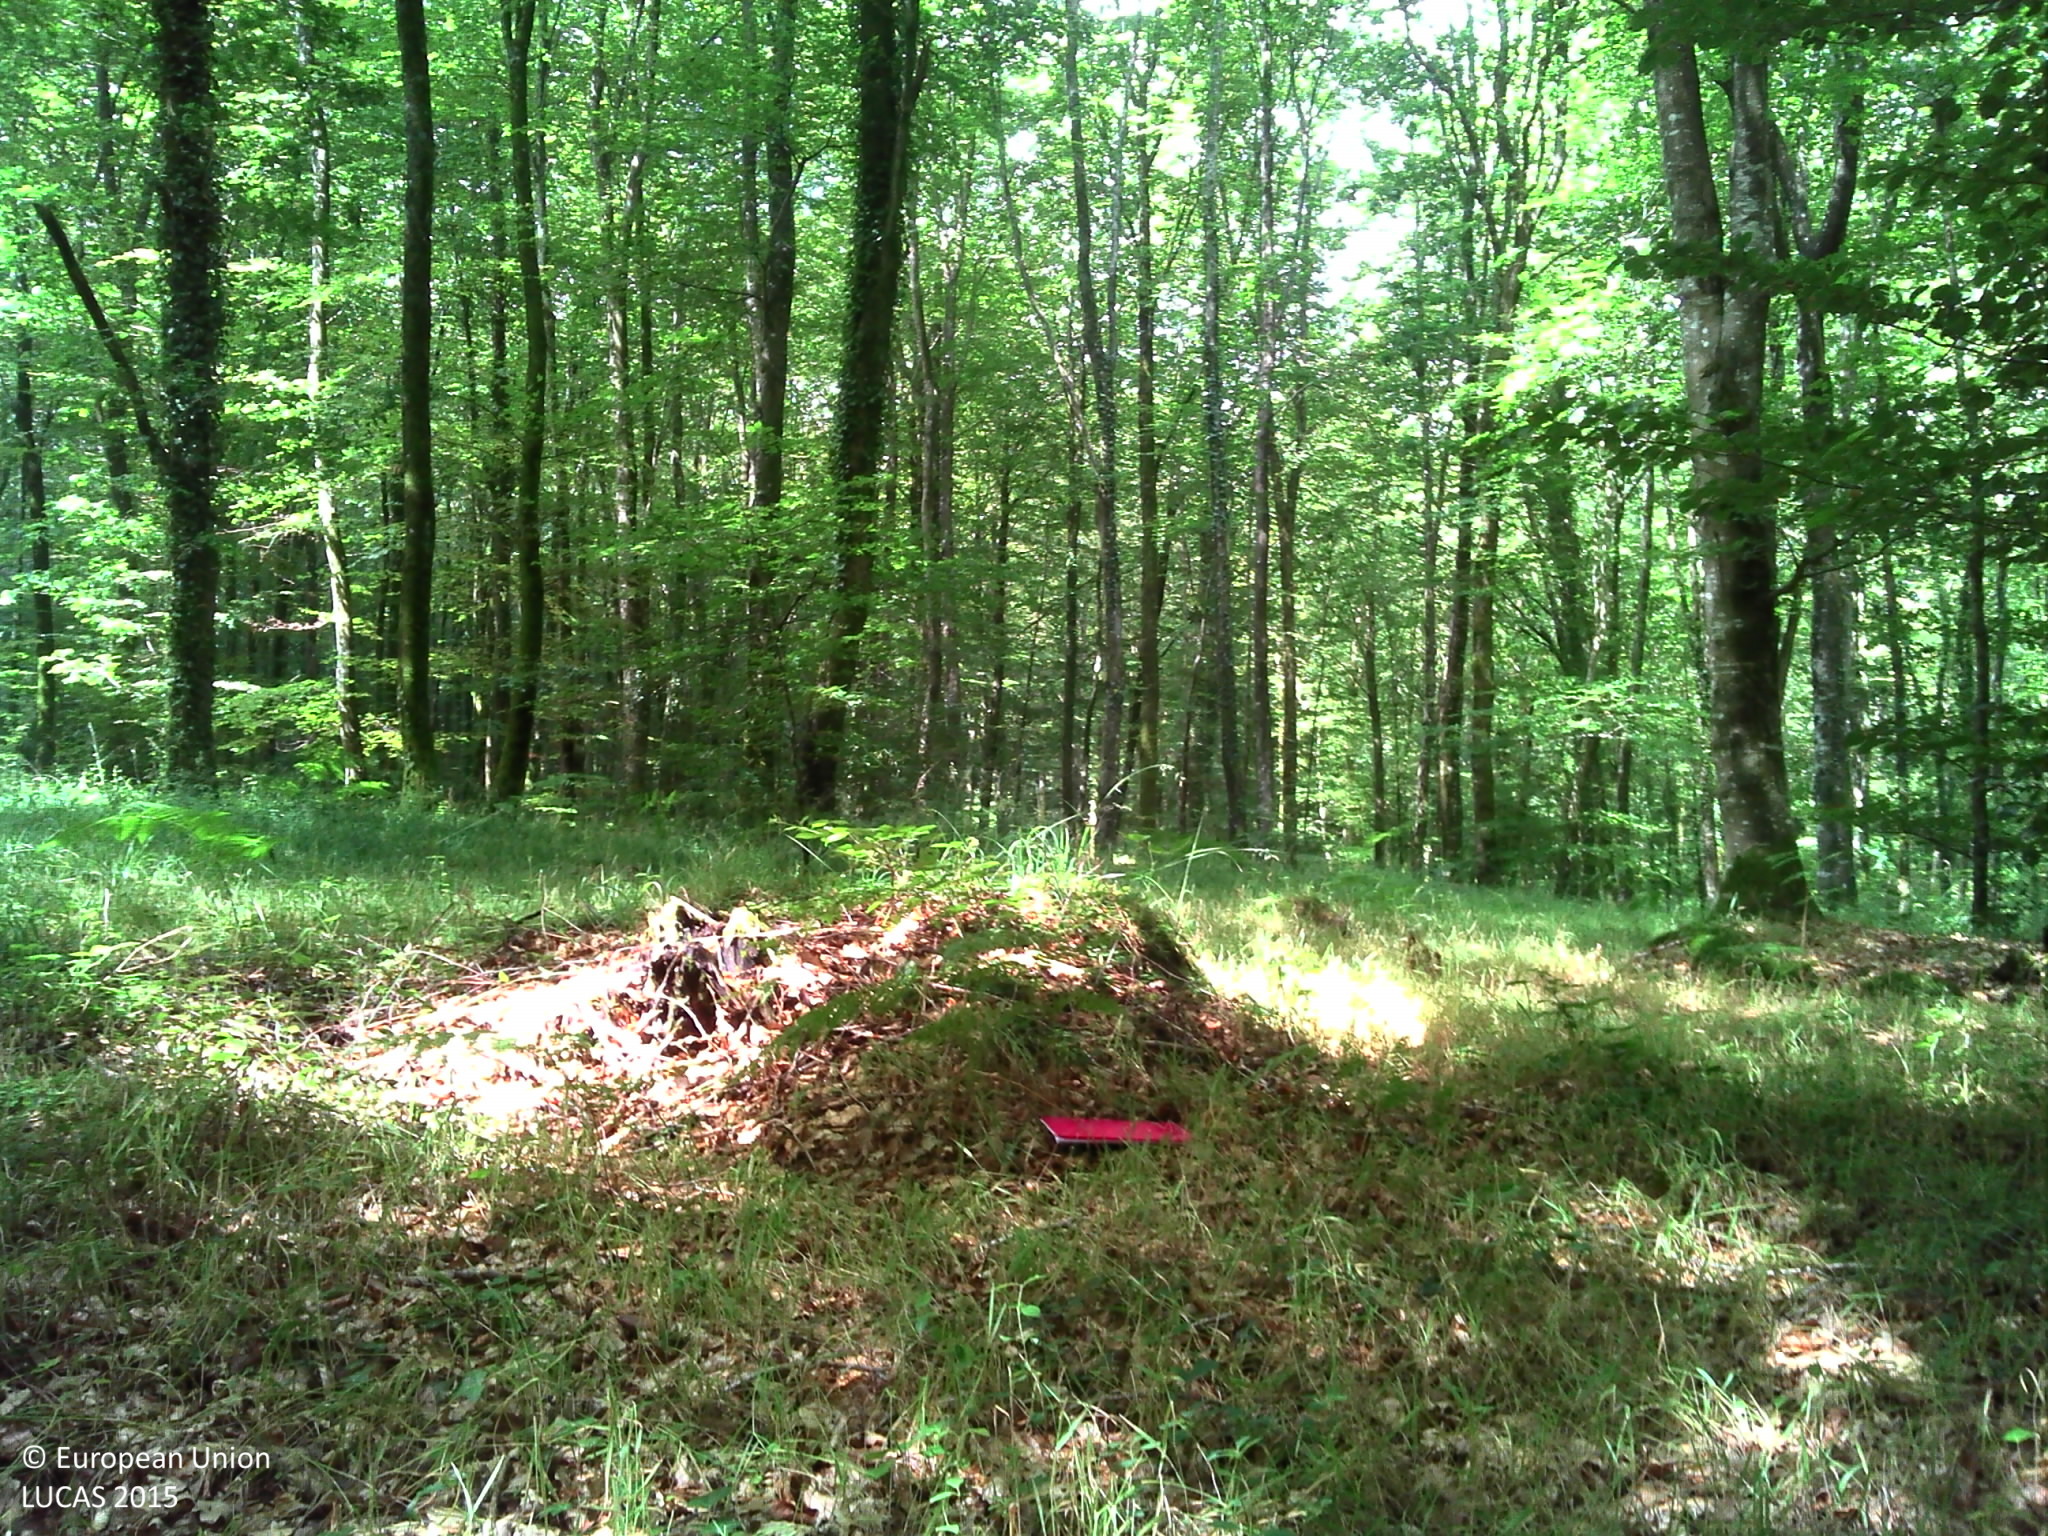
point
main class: Woodland
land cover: Broadleaved woodland
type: beech forest
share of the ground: > 75 %
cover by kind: broadleaved forest trees 80 %, herbaceous plants 20 %
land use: Forestry
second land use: Amenities, museums, leisure
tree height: > 5 m
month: July
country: FR
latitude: 48.3971
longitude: -1.1854
